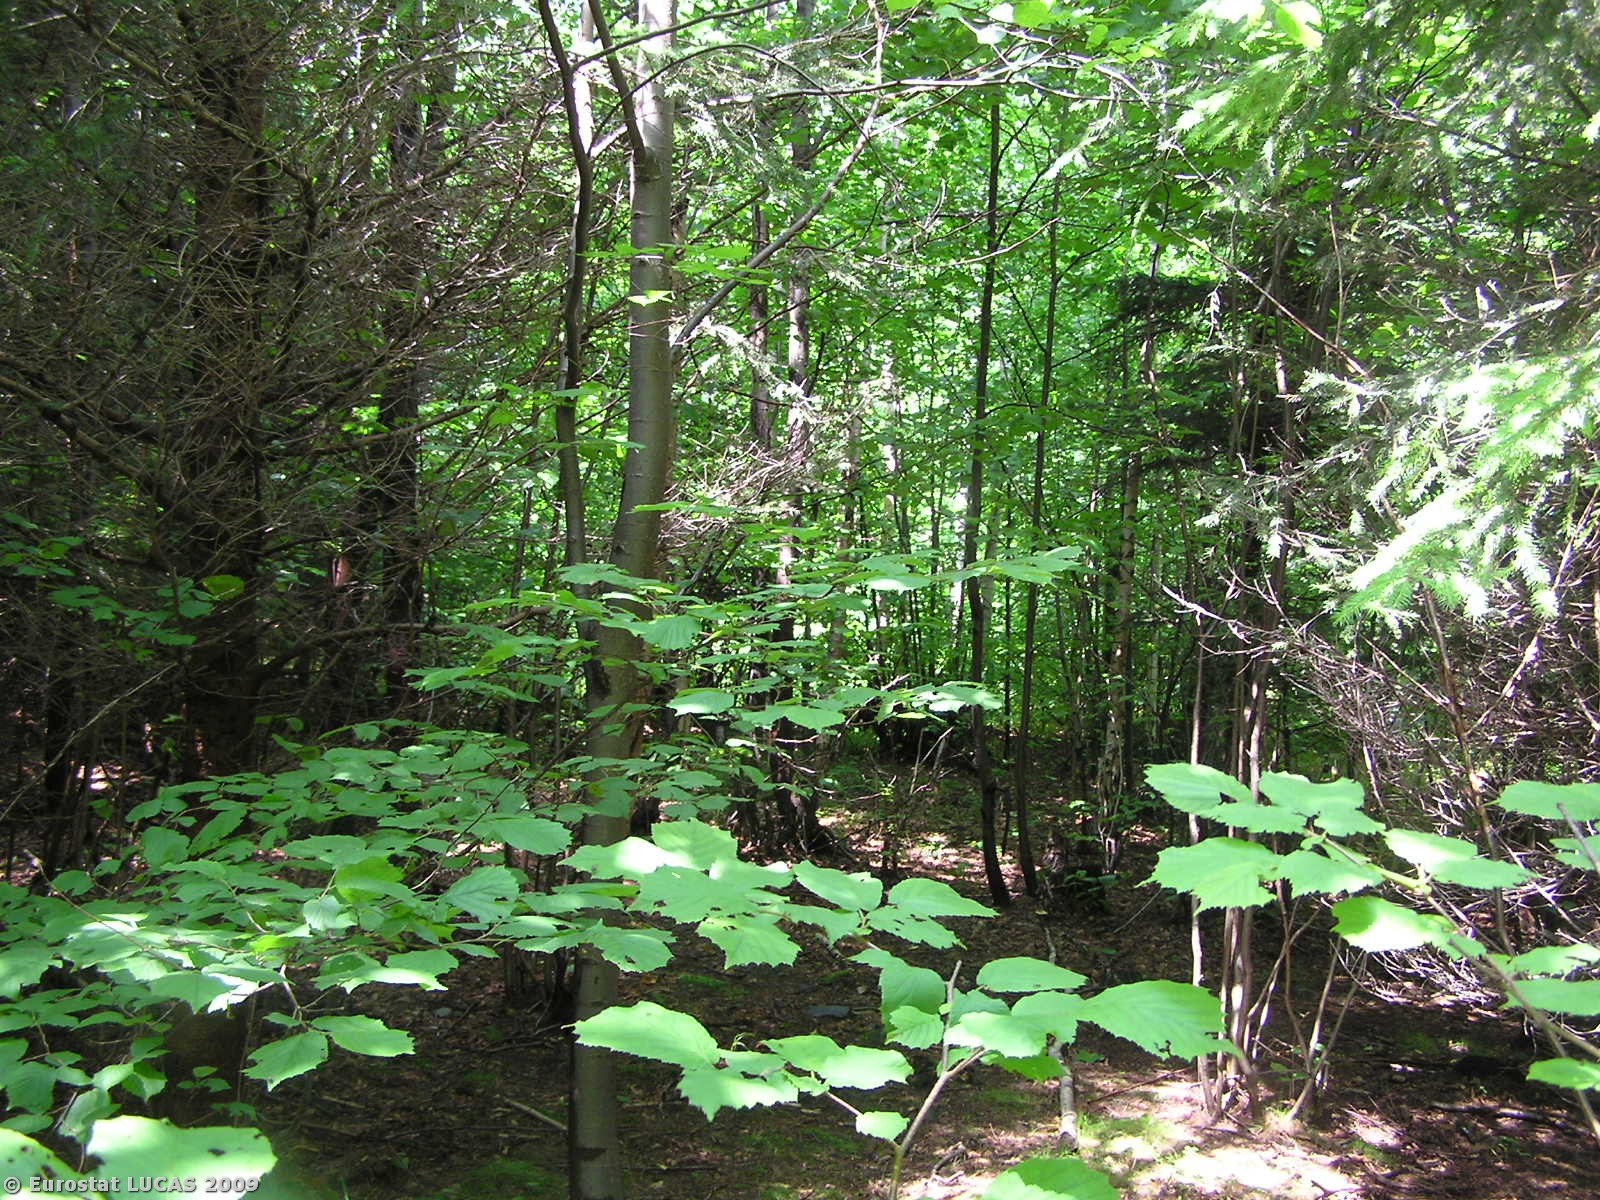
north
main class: Woodland
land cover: Mixed woodland
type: hemiboreal forest and nemoral coniferous forest and mixed broadleaved-coniferous forest
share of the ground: > 75 %
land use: Forestry
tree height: > 5 m
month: June
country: CZ
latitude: 50.2253
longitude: 17.5116
